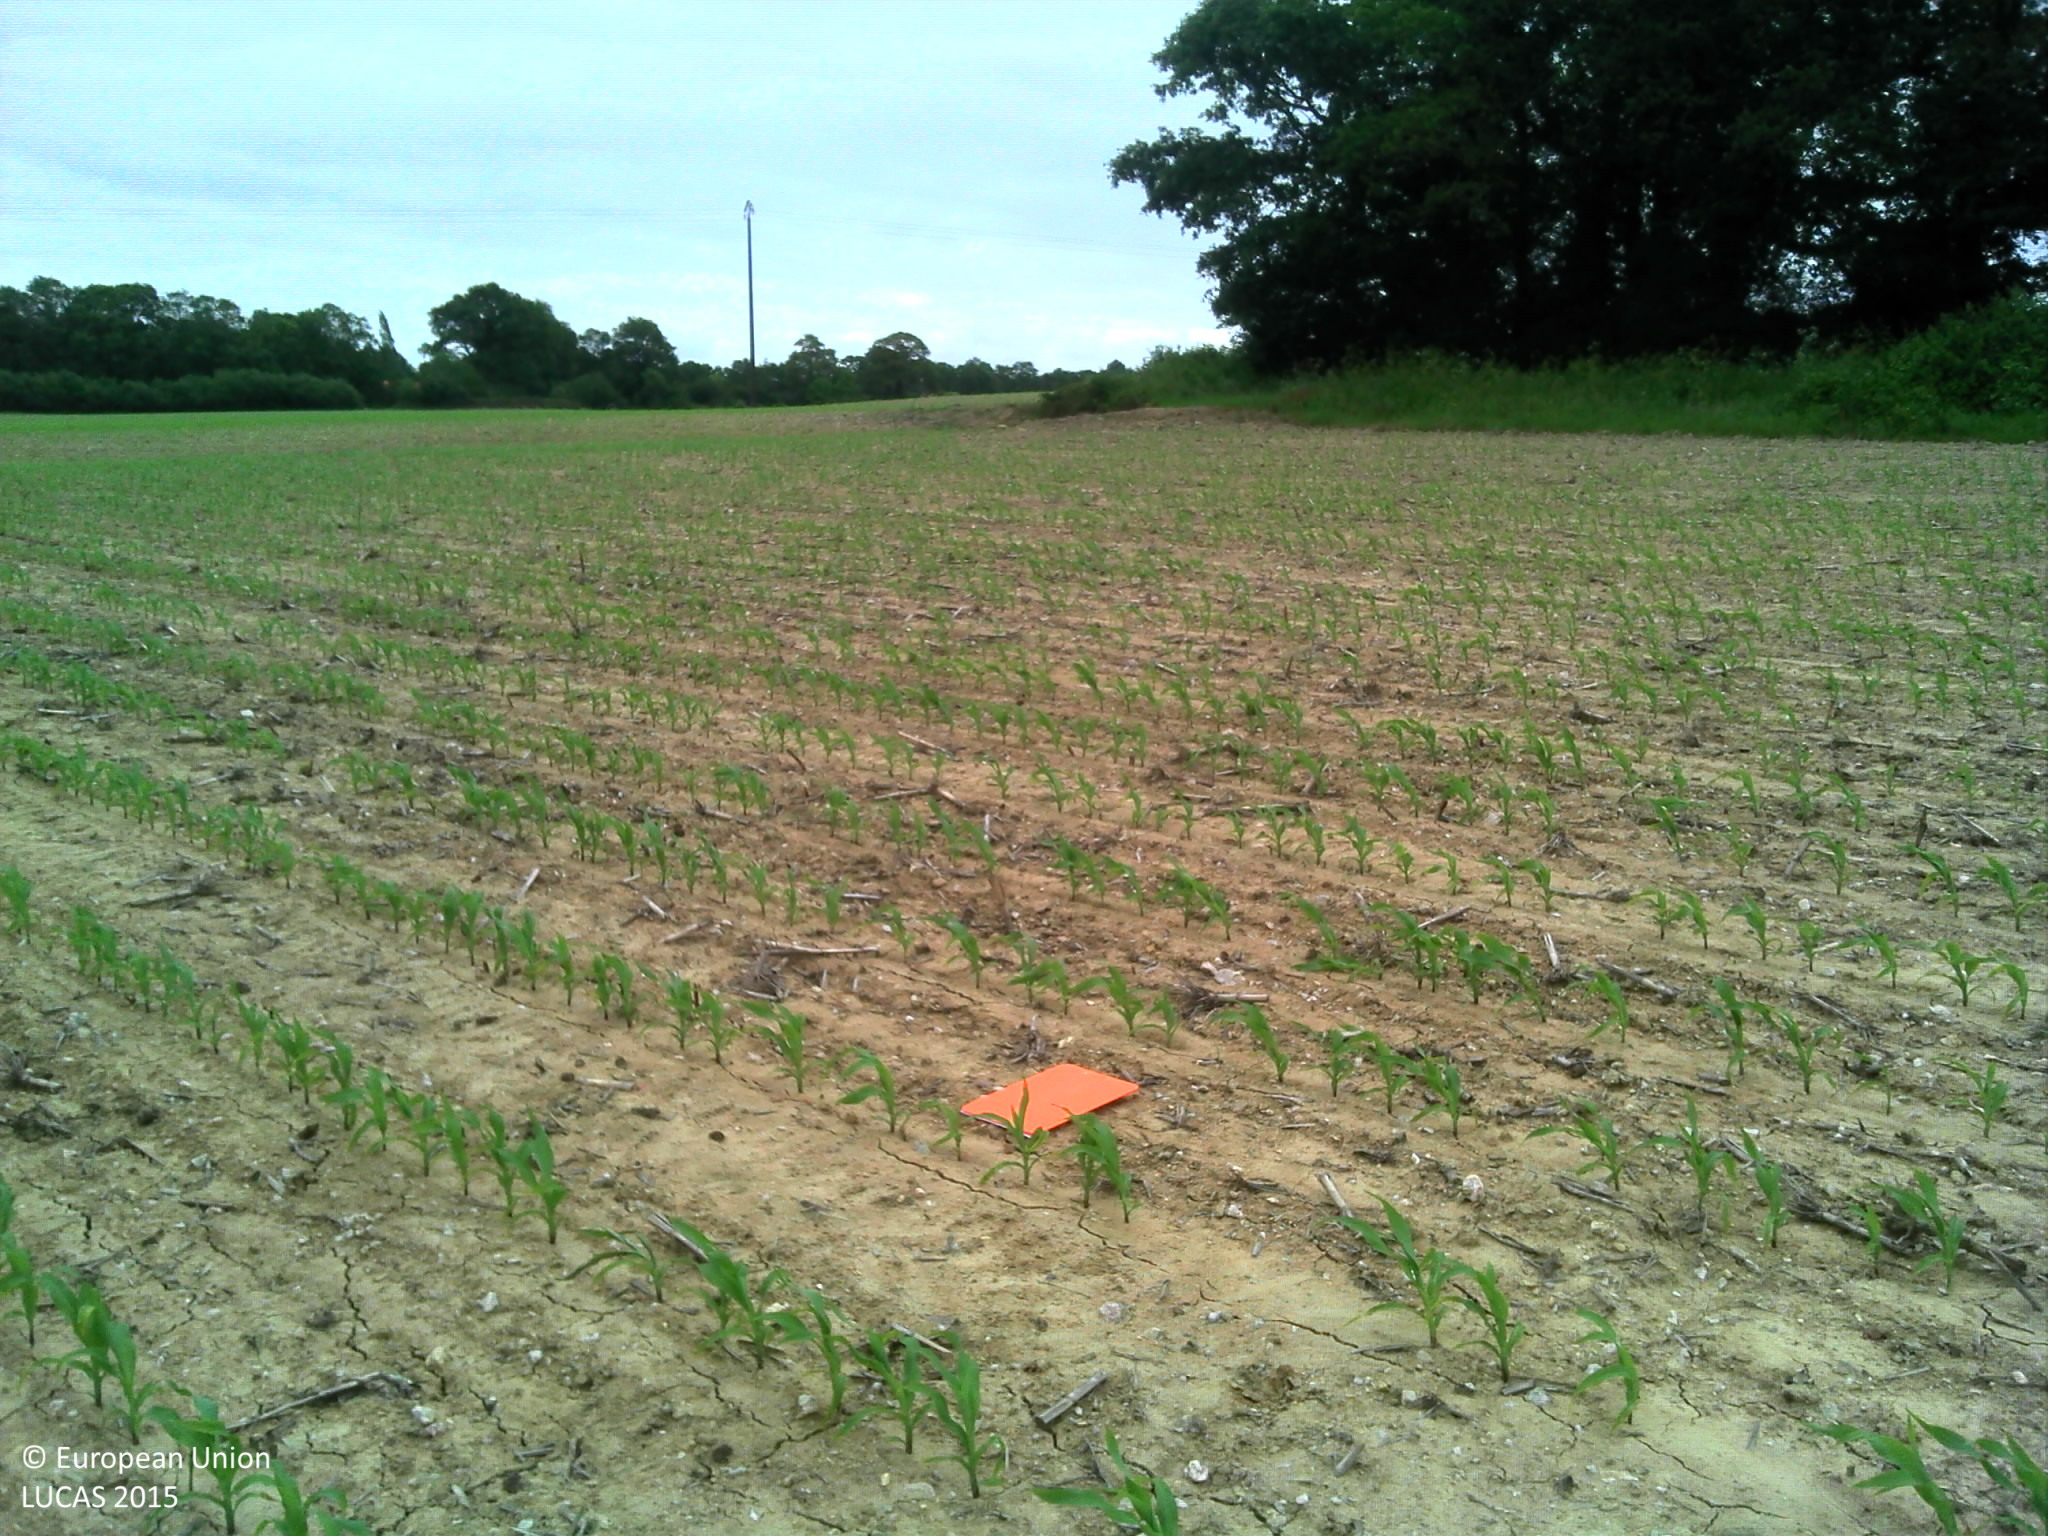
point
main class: Cropland
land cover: Maize
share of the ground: 10 - 25 %
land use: Agriculture (excluding fallow land and kitchen gardens)
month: June
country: FR
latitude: 46.8943
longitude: -1.8174
